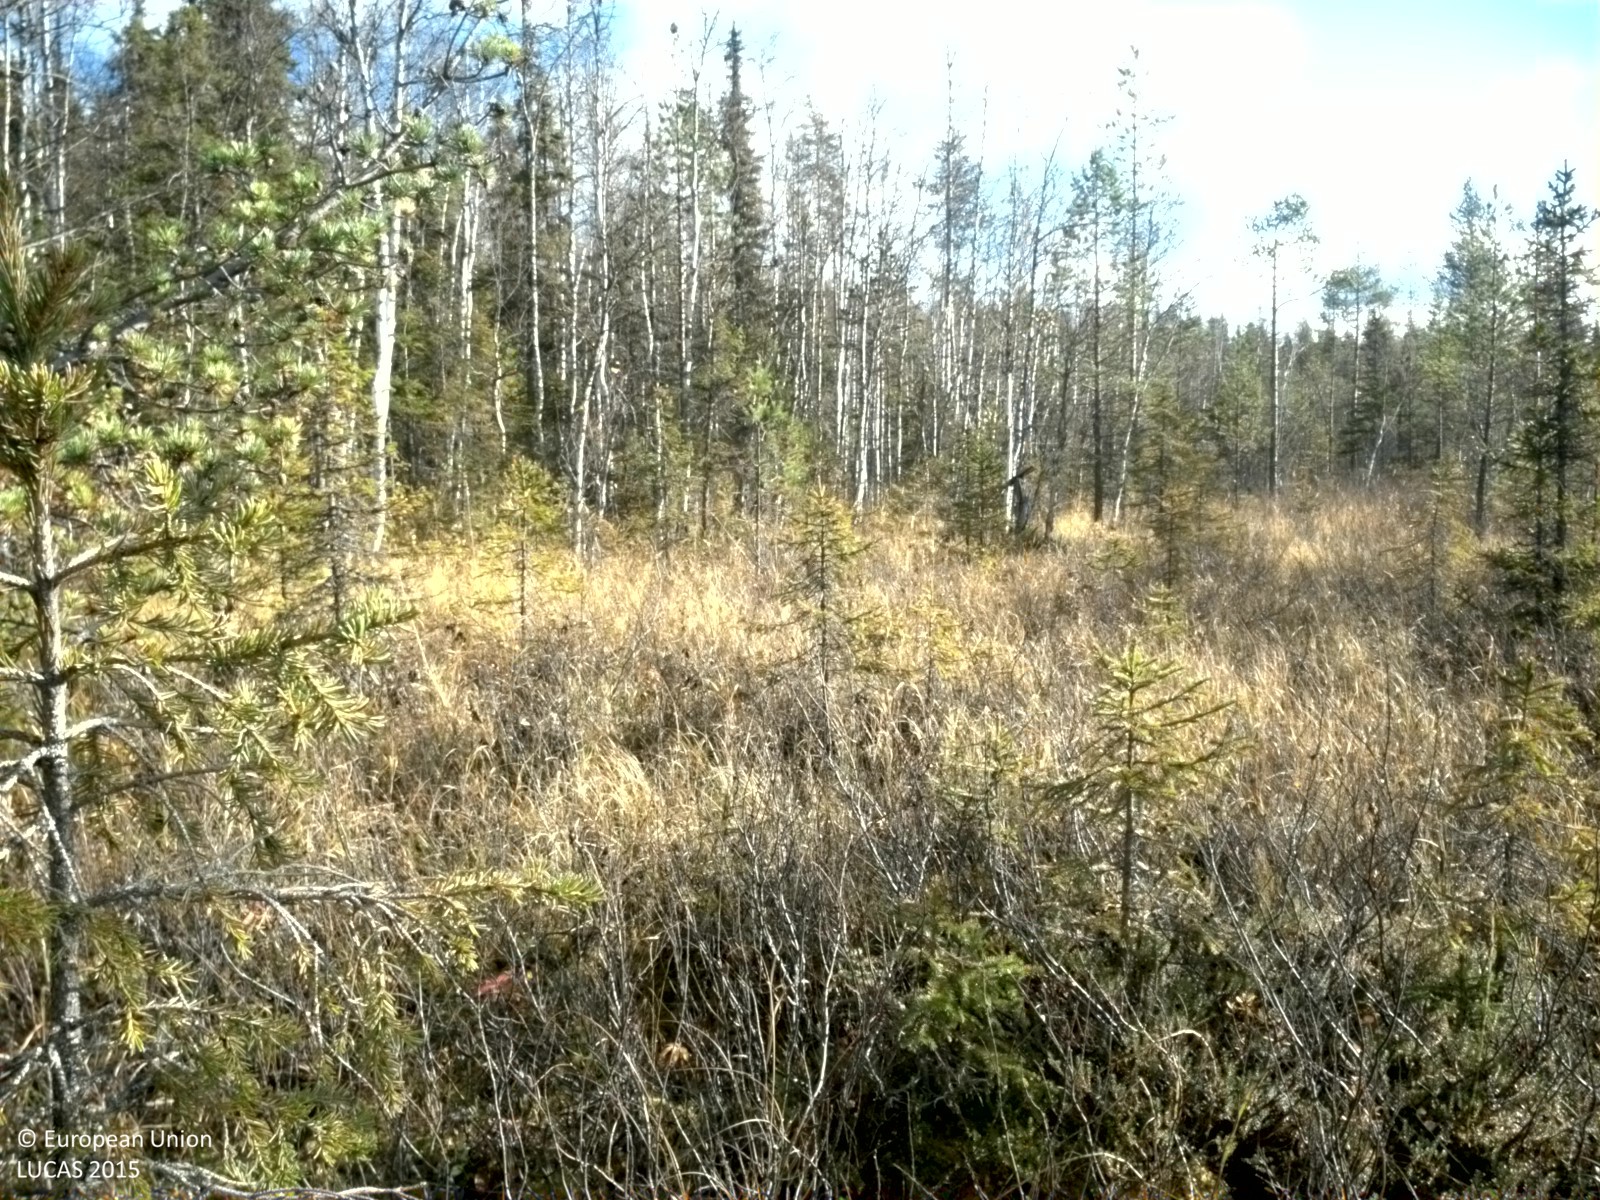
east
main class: Woodland
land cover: Pine dominated coniferous woodland
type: mire and swamp forests
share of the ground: 10 - 25 %
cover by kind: herbaceous plants 75 %, coniferous forest trees 15 %, shrubs 10 %
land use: Forestry
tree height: > 5 m
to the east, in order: Pine dominated coniferous woodland; Spruce dominated mixed woodland; Spruce dominated coniferous woodland; Other coniferous woodland; Tracks; Groves; Ditches and canals; Spruce dominated coniferous woodland
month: October
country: SE
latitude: 65.7768
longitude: 21.4381
